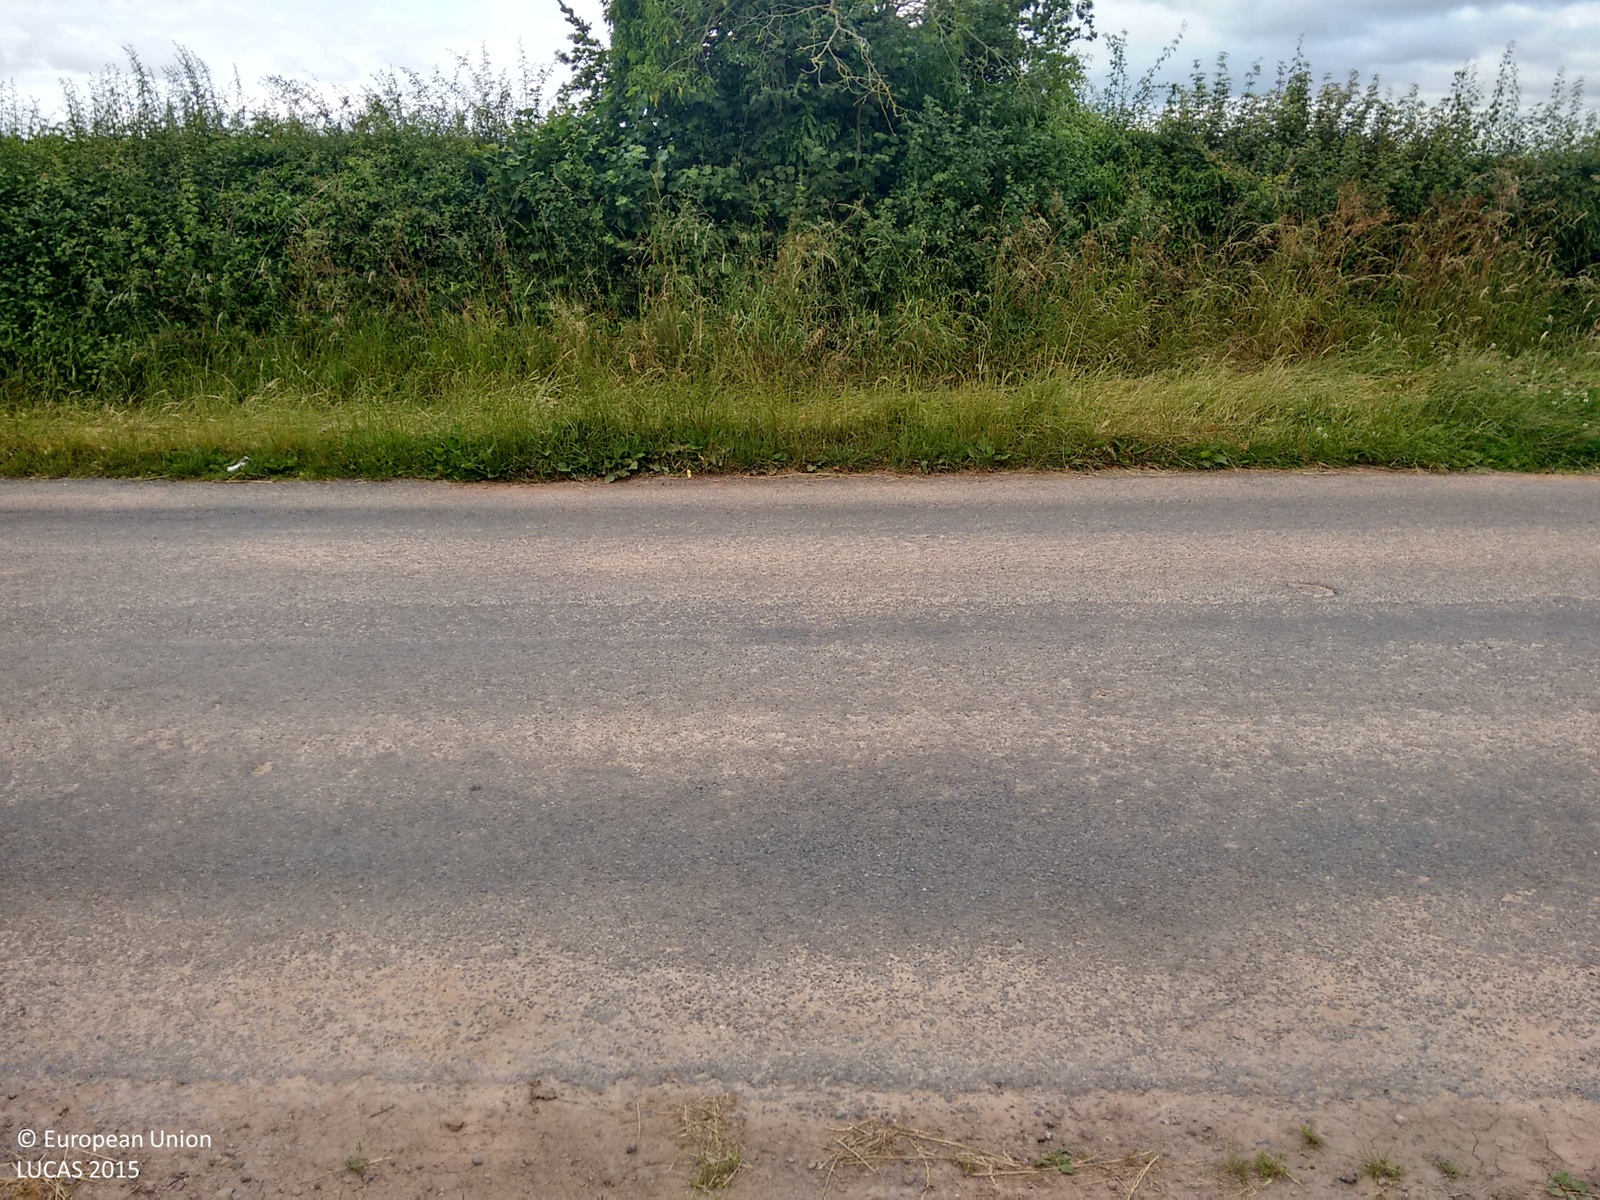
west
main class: Cropland
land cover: Barley
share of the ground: > 75 %
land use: Agriculture (excluding fallow land and kitchen gardens)
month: July
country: GB
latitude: 52.2373
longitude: -2.7073
